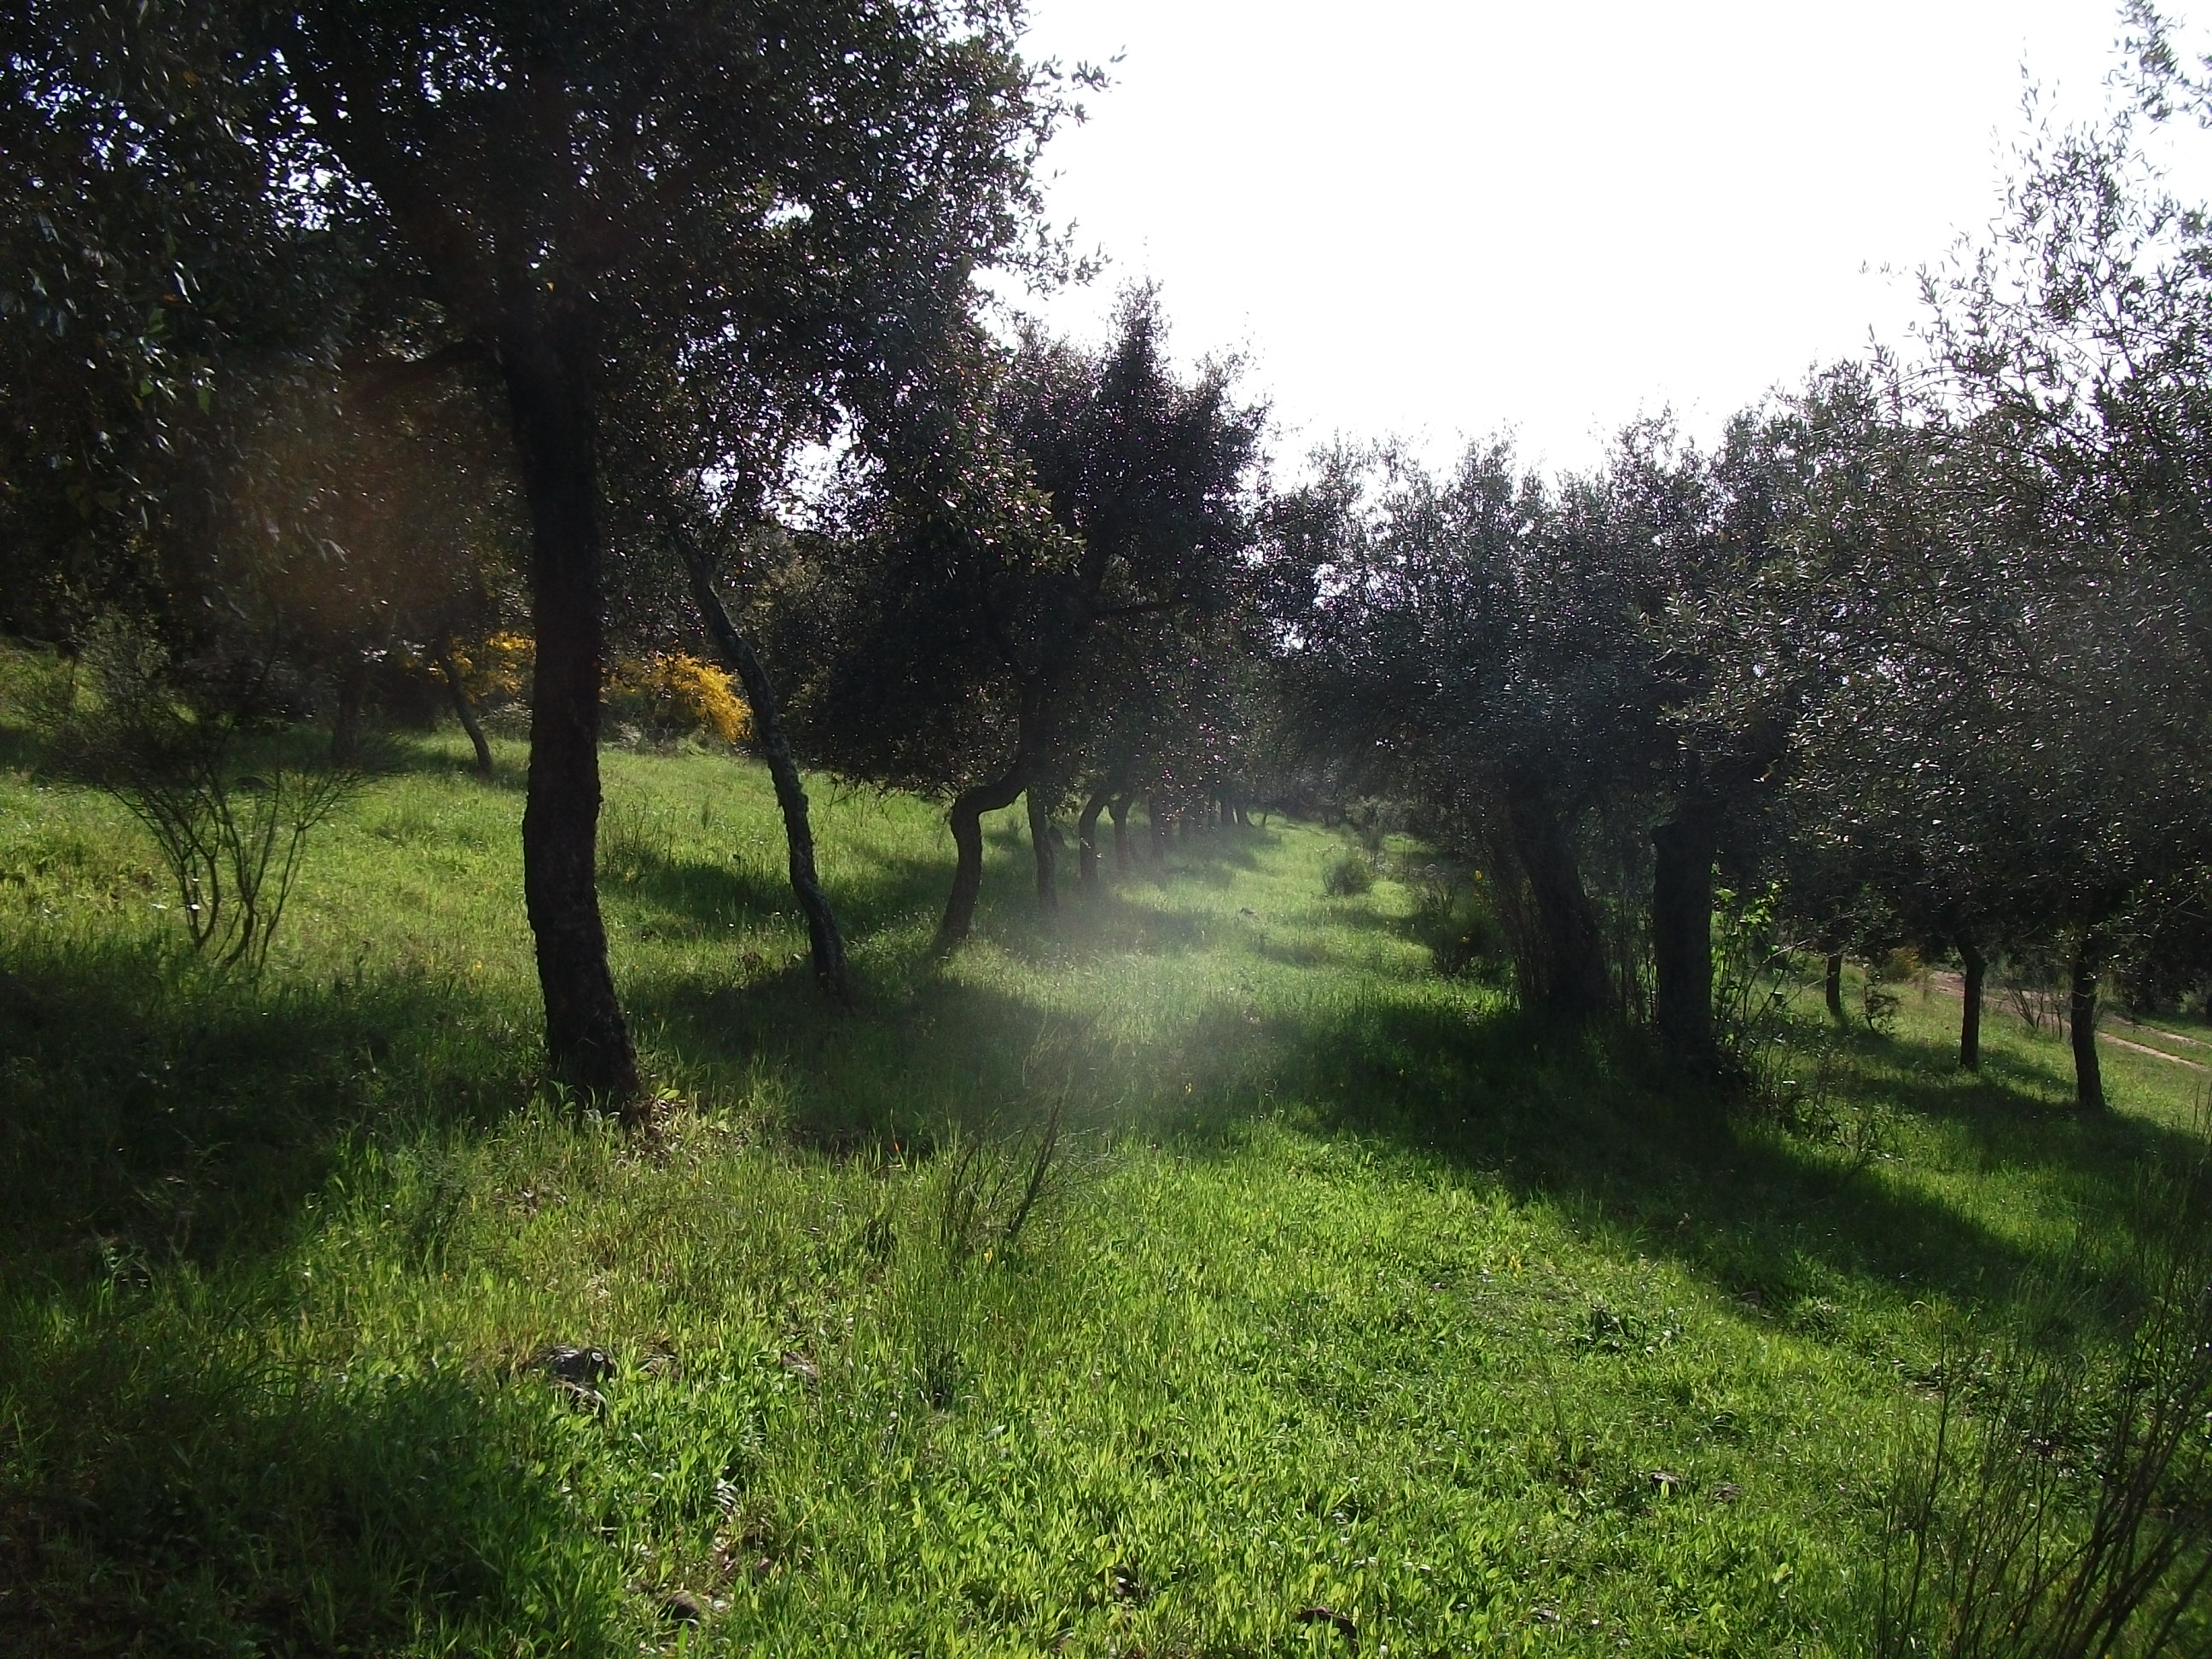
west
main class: Woodland
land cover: Broadleaved woodland
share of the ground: 50 - 75 %
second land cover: Olive groves
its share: 10 - 25 %
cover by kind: broadleaved forest trees 70 %, herbaceous plants 10 %
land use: Forestry
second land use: Agriculture (excluding fallow land and kitchen gardens)
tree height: < 5 m
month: April
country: ES
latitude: 38.0817
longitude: -6.7293
